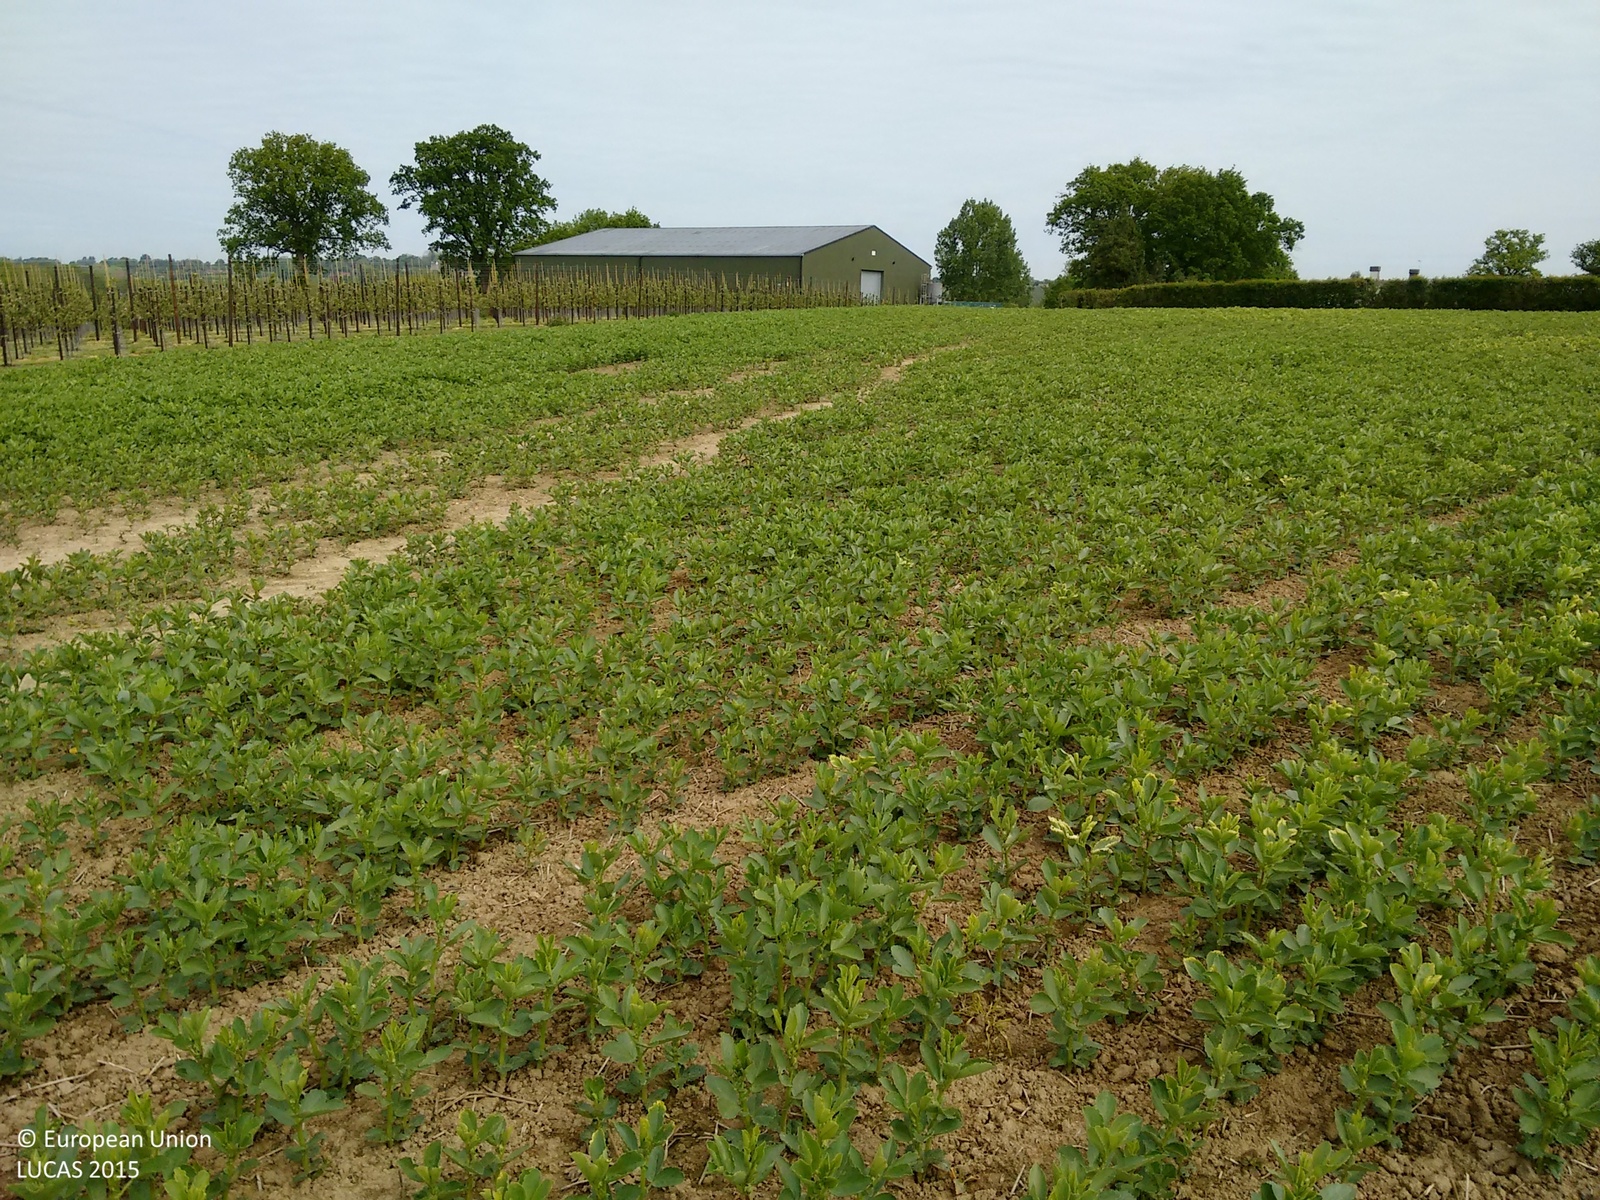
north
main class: Cropland
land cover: Dry pulses
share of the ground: > 75 %
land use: Agriculture (excluding fallow land and kitchen gardens)
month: May
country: GB
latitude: 51.1373
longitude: 0.4099
